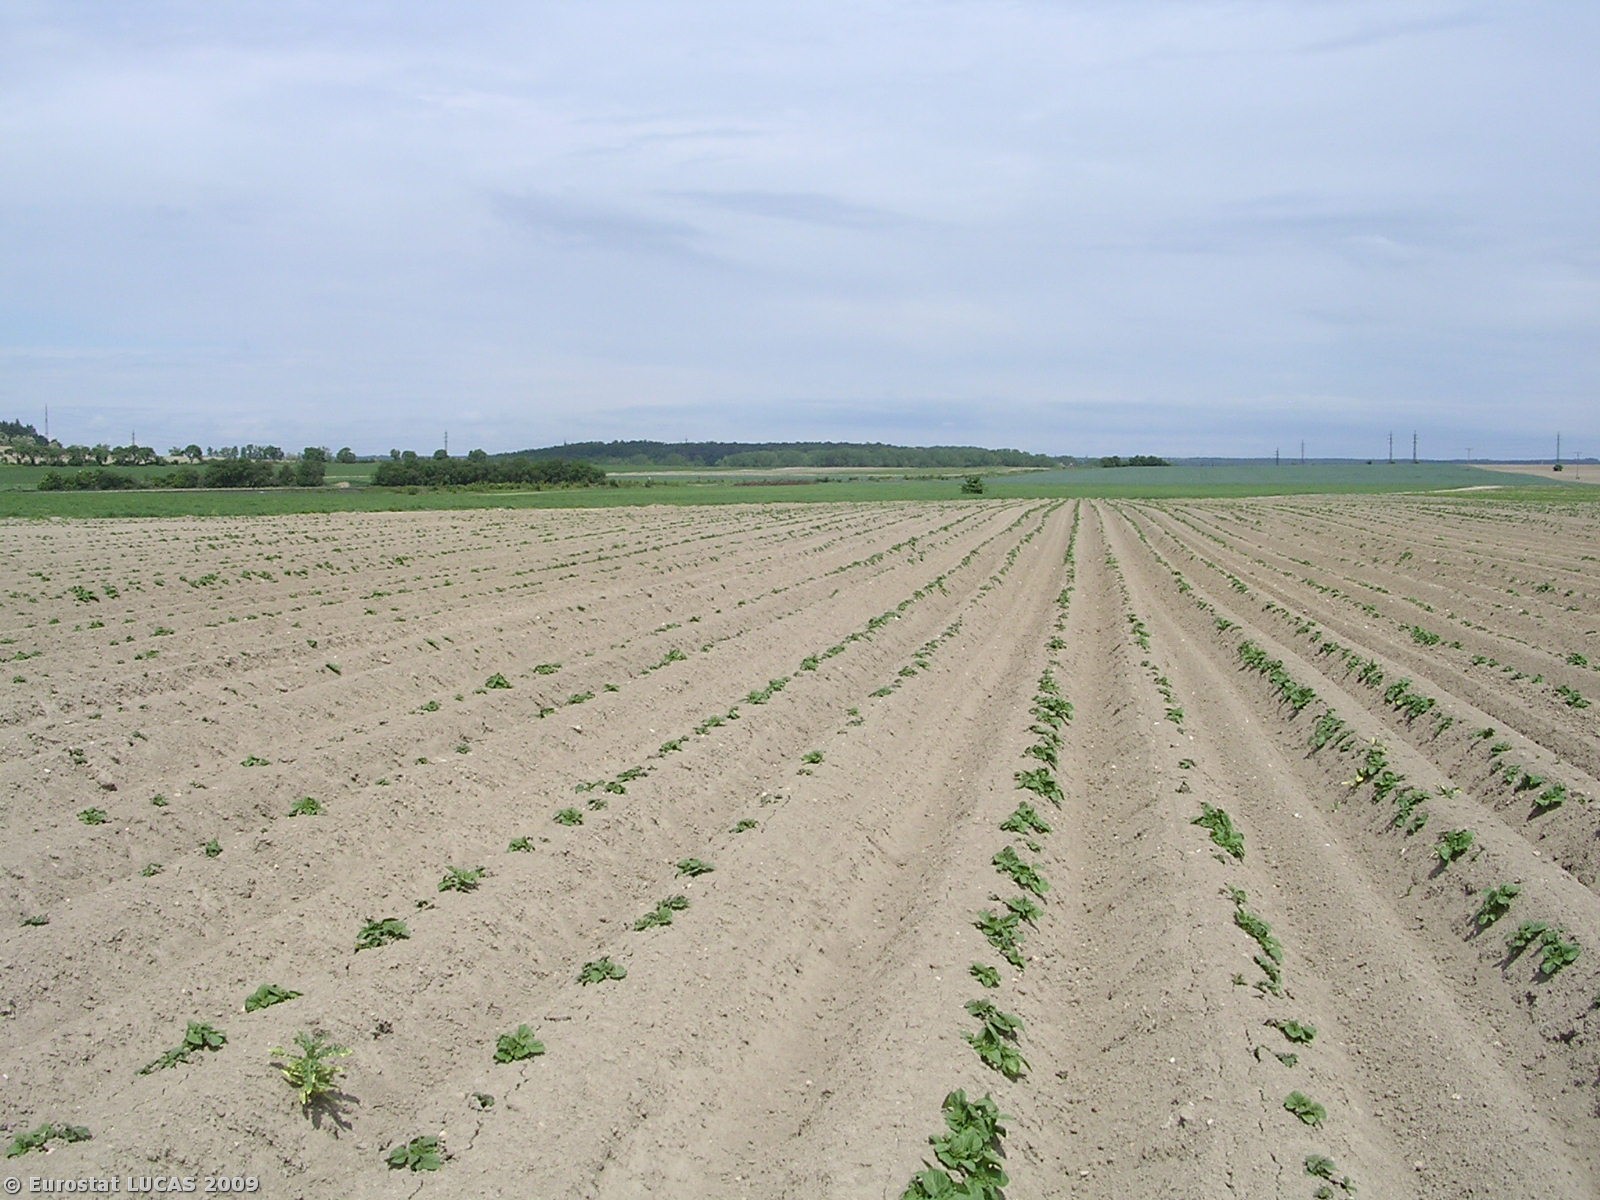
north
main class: Cropland
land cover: Potatoes
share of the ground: 10 - 25 %
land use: Agriculture (excluding fallow land and kitchen gardens)
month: May
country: CZ
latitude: 50.2066
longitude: 14.8644
